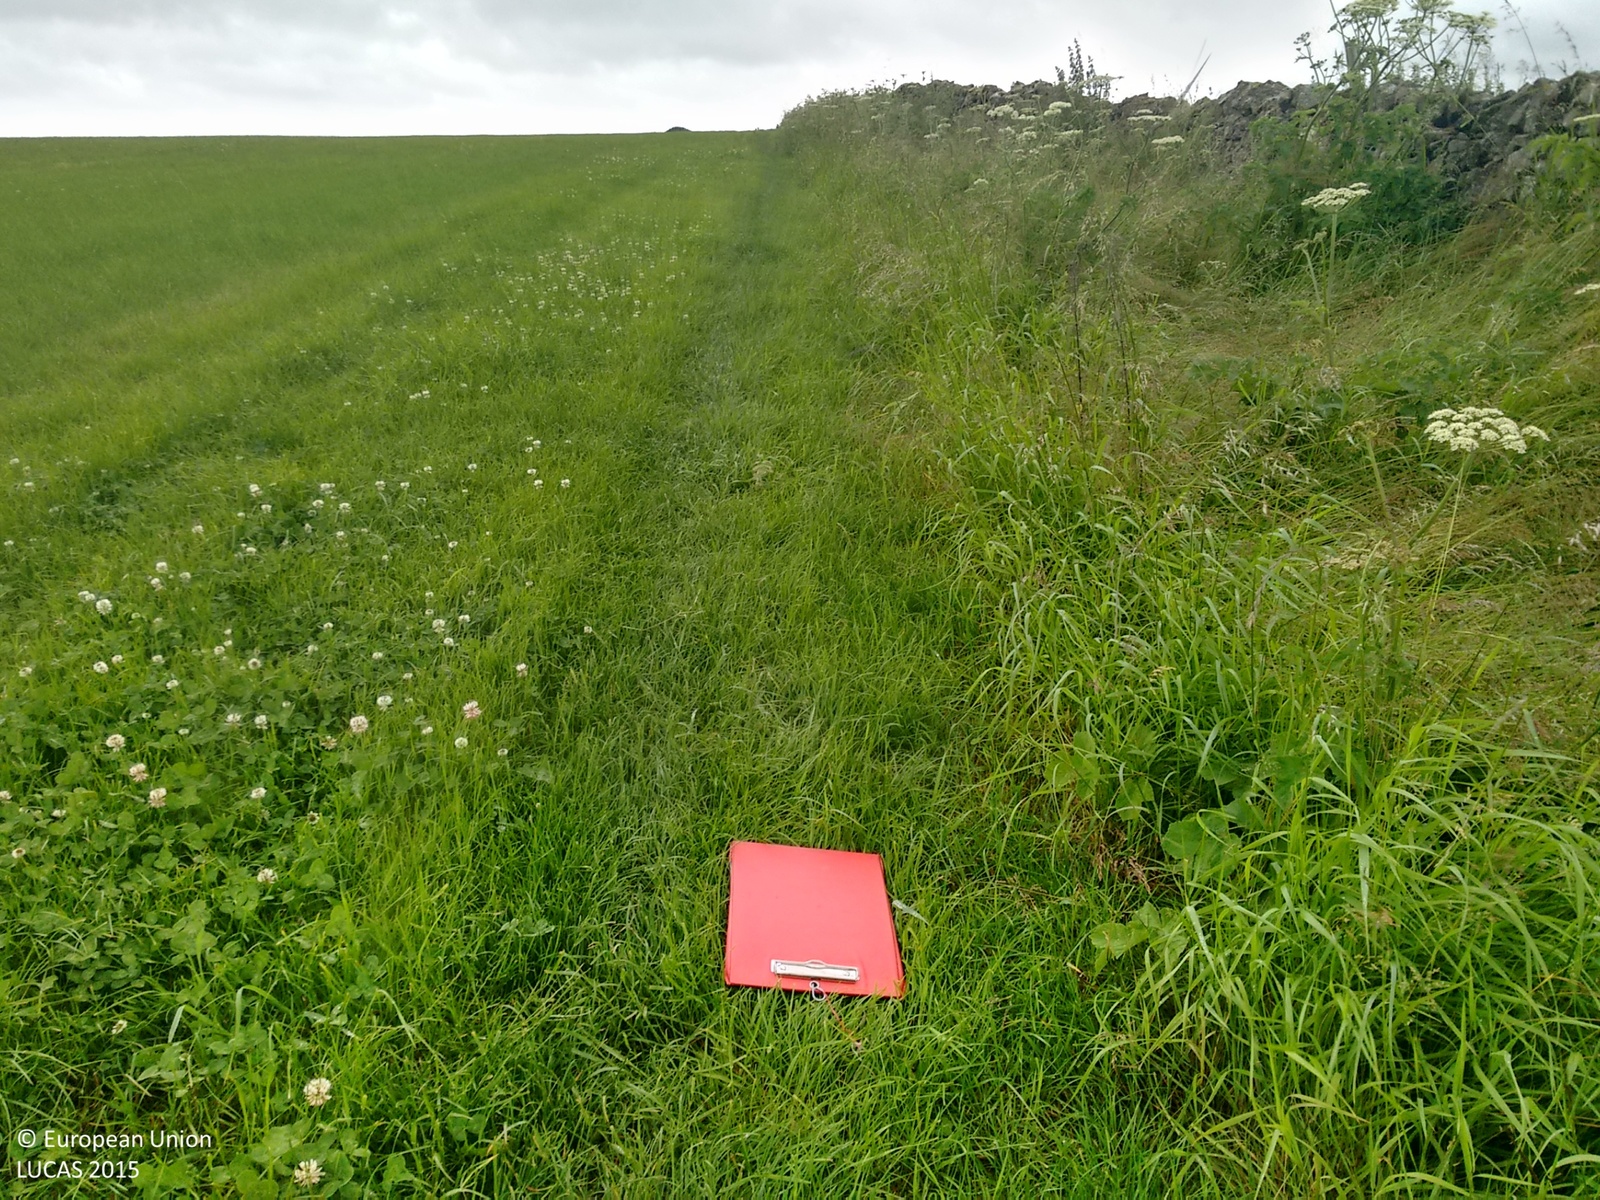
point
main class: Grassland
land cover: Grassland without tree/shrub cover
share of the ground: > 75 %
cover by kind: herbaceous plants 100 %
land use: Agriculture (excluding fallow land and kitchen gardens)
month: July
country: GB
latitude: 53.0942
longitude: -1.6255
